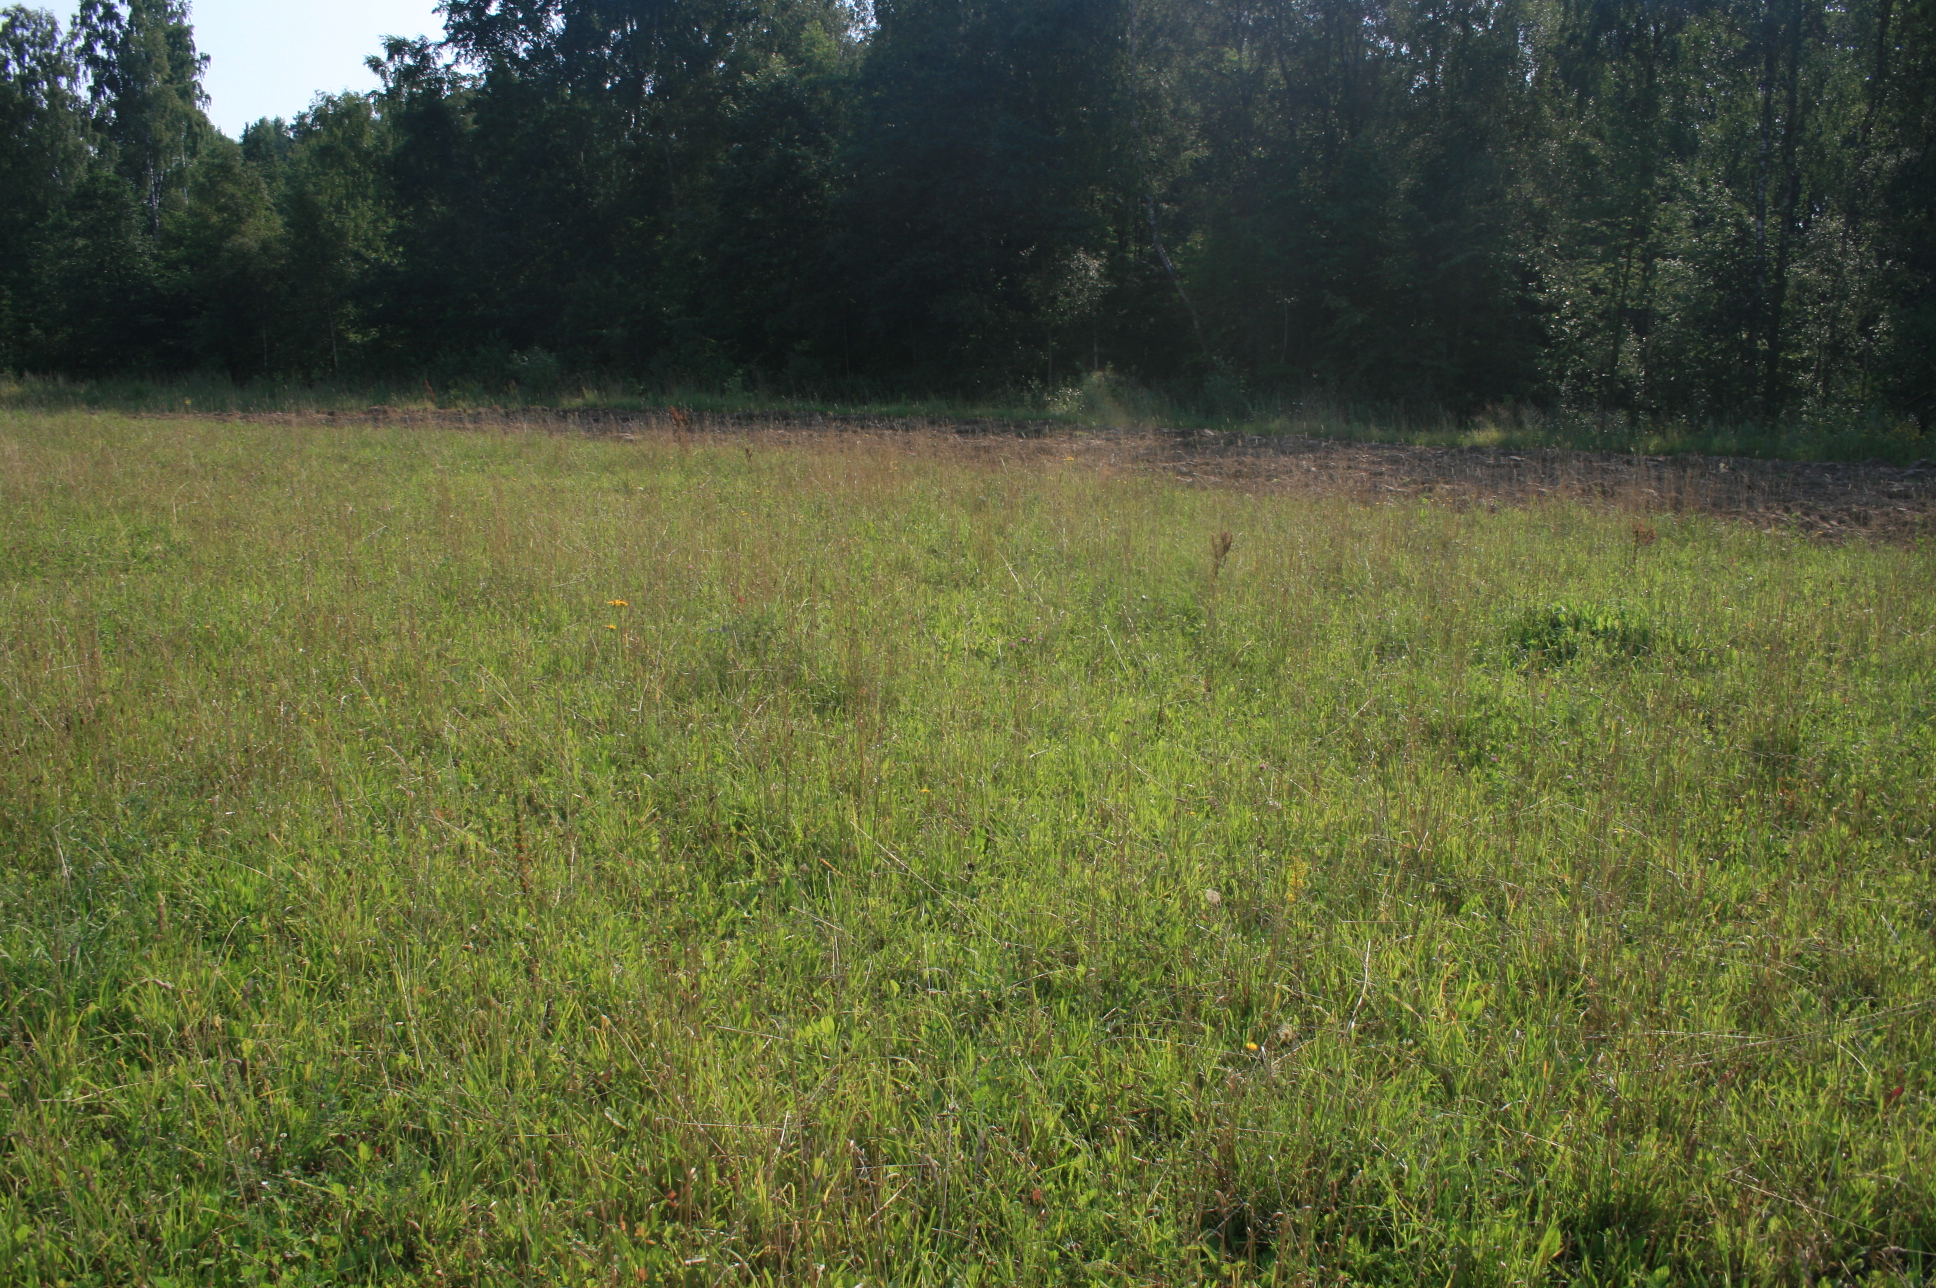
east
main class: Grassland
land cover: Grassland without tree/shrub cover
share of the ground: > 75 %
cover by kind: herbaceous plants 100 %
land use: Agriculture (excluding fallow land and kitchen gardens)
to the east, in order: Grassland without tree/shrub cover; Other bare soil; Spontaneously vegetated surfaces; Ditches and canals; Broadleaved woodland; Other mixed woodland; Spruce dominated mixed woodland; Other mixed woodland
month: August
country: LT
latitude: 55.6036
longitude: 21.8114
